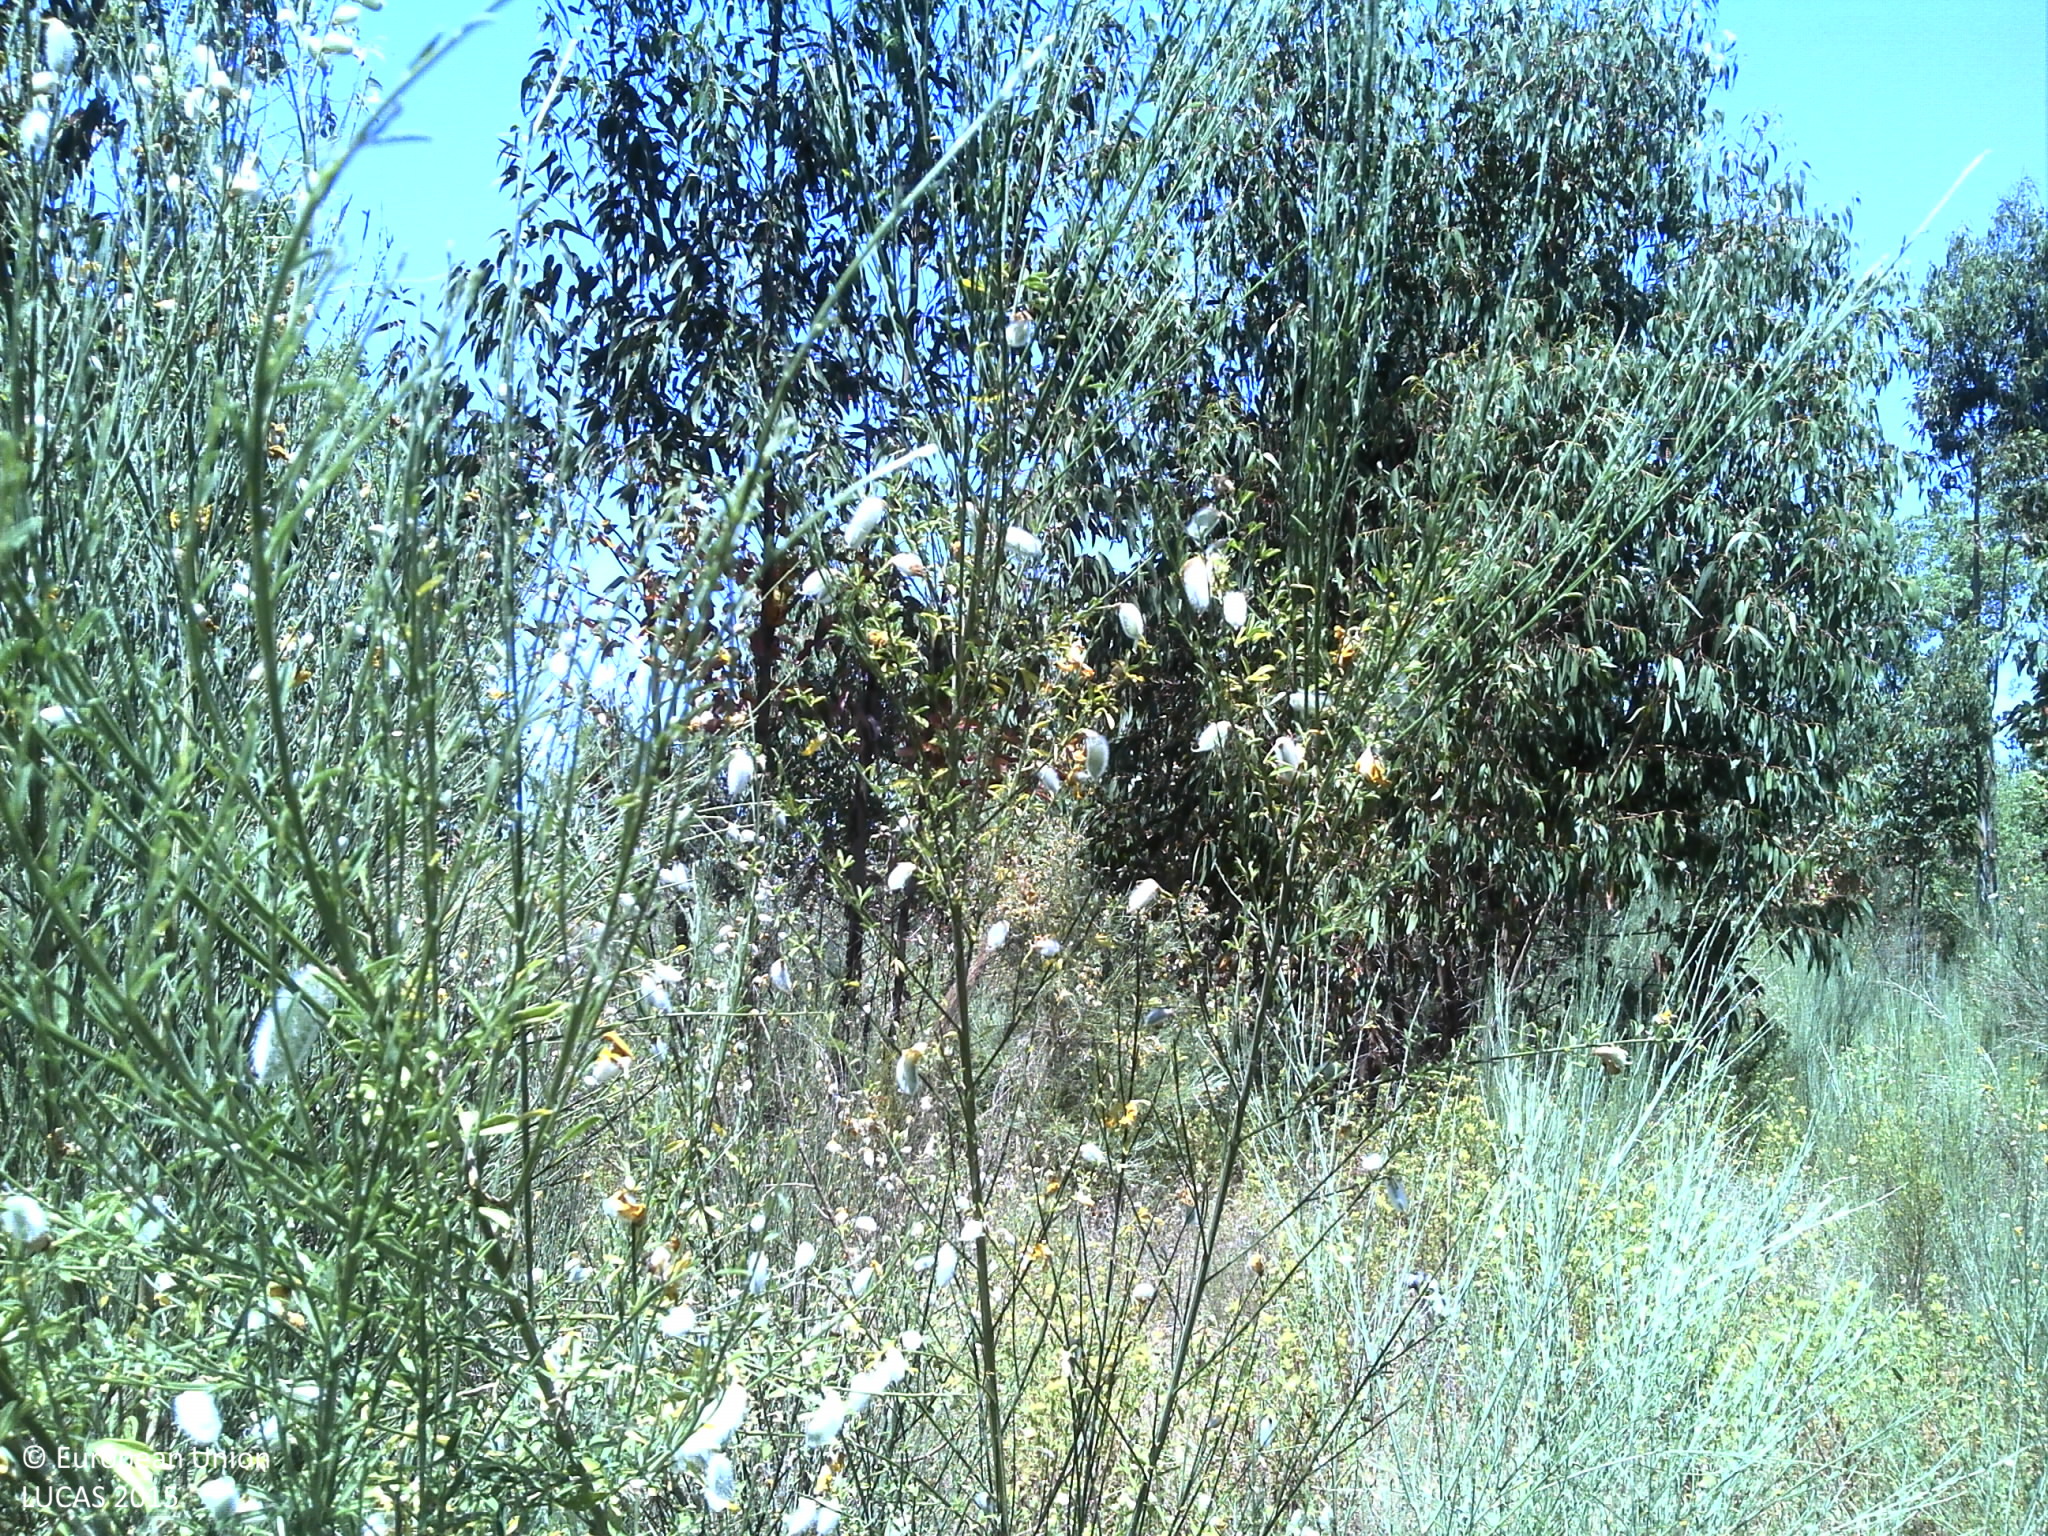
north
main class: Woodland
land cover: Broadleaved woodland
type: exotic forest
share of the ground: 50 - 75 %
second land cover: Shrubland without tree cover
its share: > 75 %
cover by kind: broadleaved forest trees 75 %, shrubs 25 %
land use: Forestry
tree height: > 5 m
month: May
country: PT
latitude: 39.4688
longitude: -7.7316
